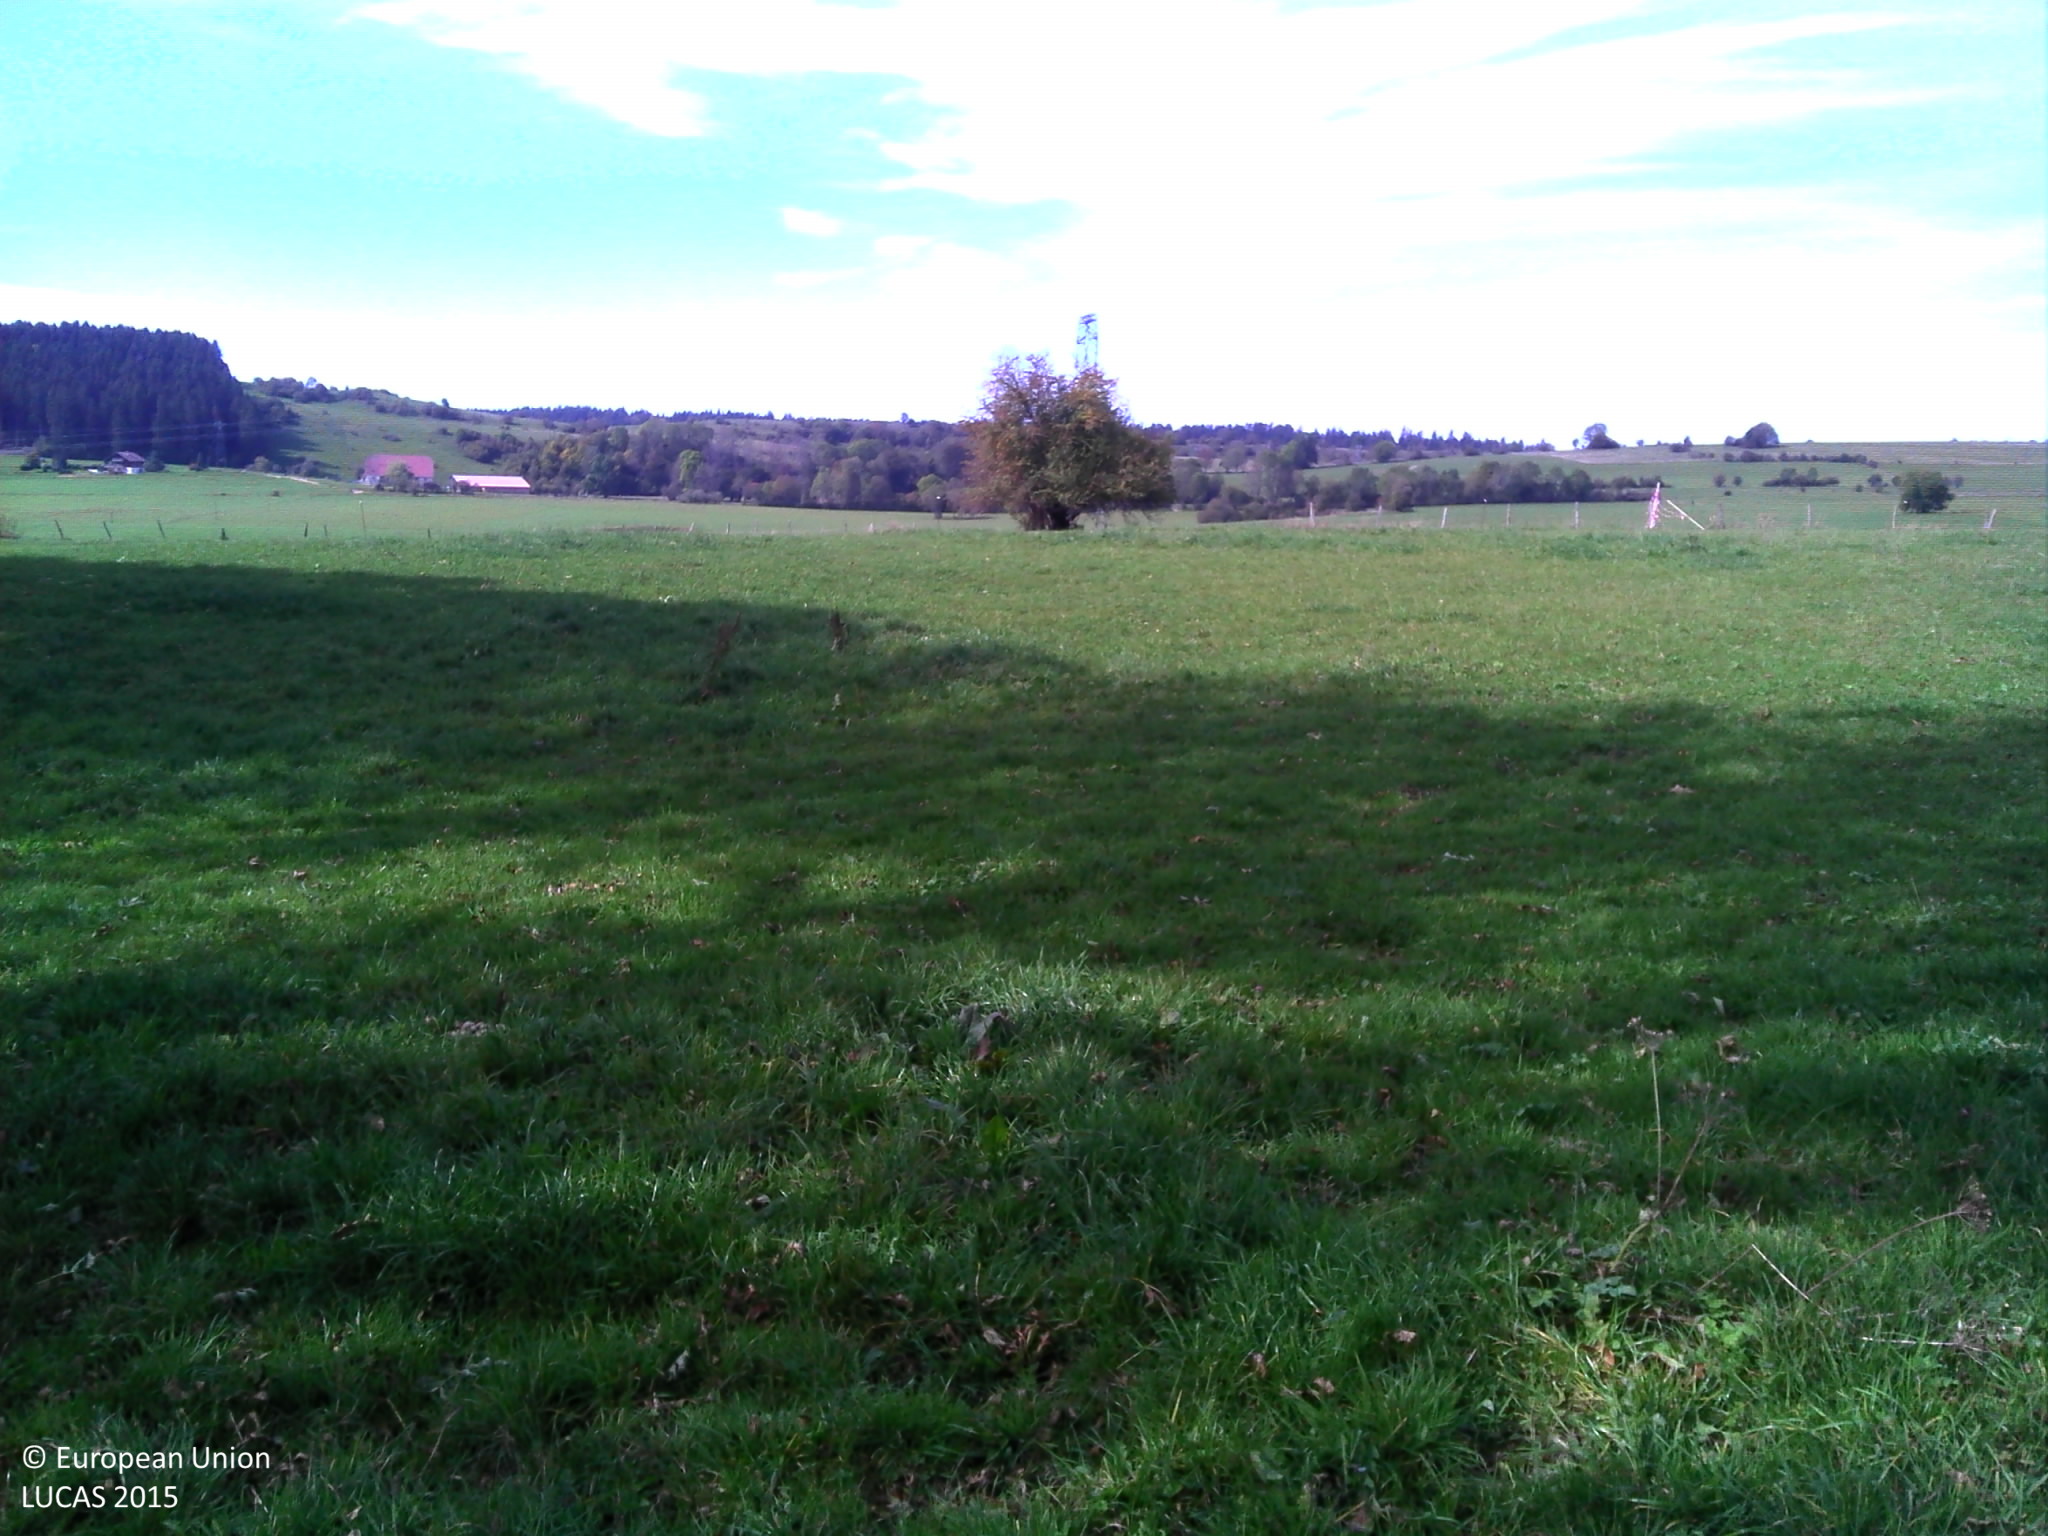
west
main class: Grassland
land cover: Grassland without tree/shrub cover
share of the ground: > 75 %
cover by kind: herbaceous plants 100 %
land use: Agriculture (excluding fallow land and kitchen gardens)
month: October
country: FR
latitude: 46.9564
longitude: 6.3624
